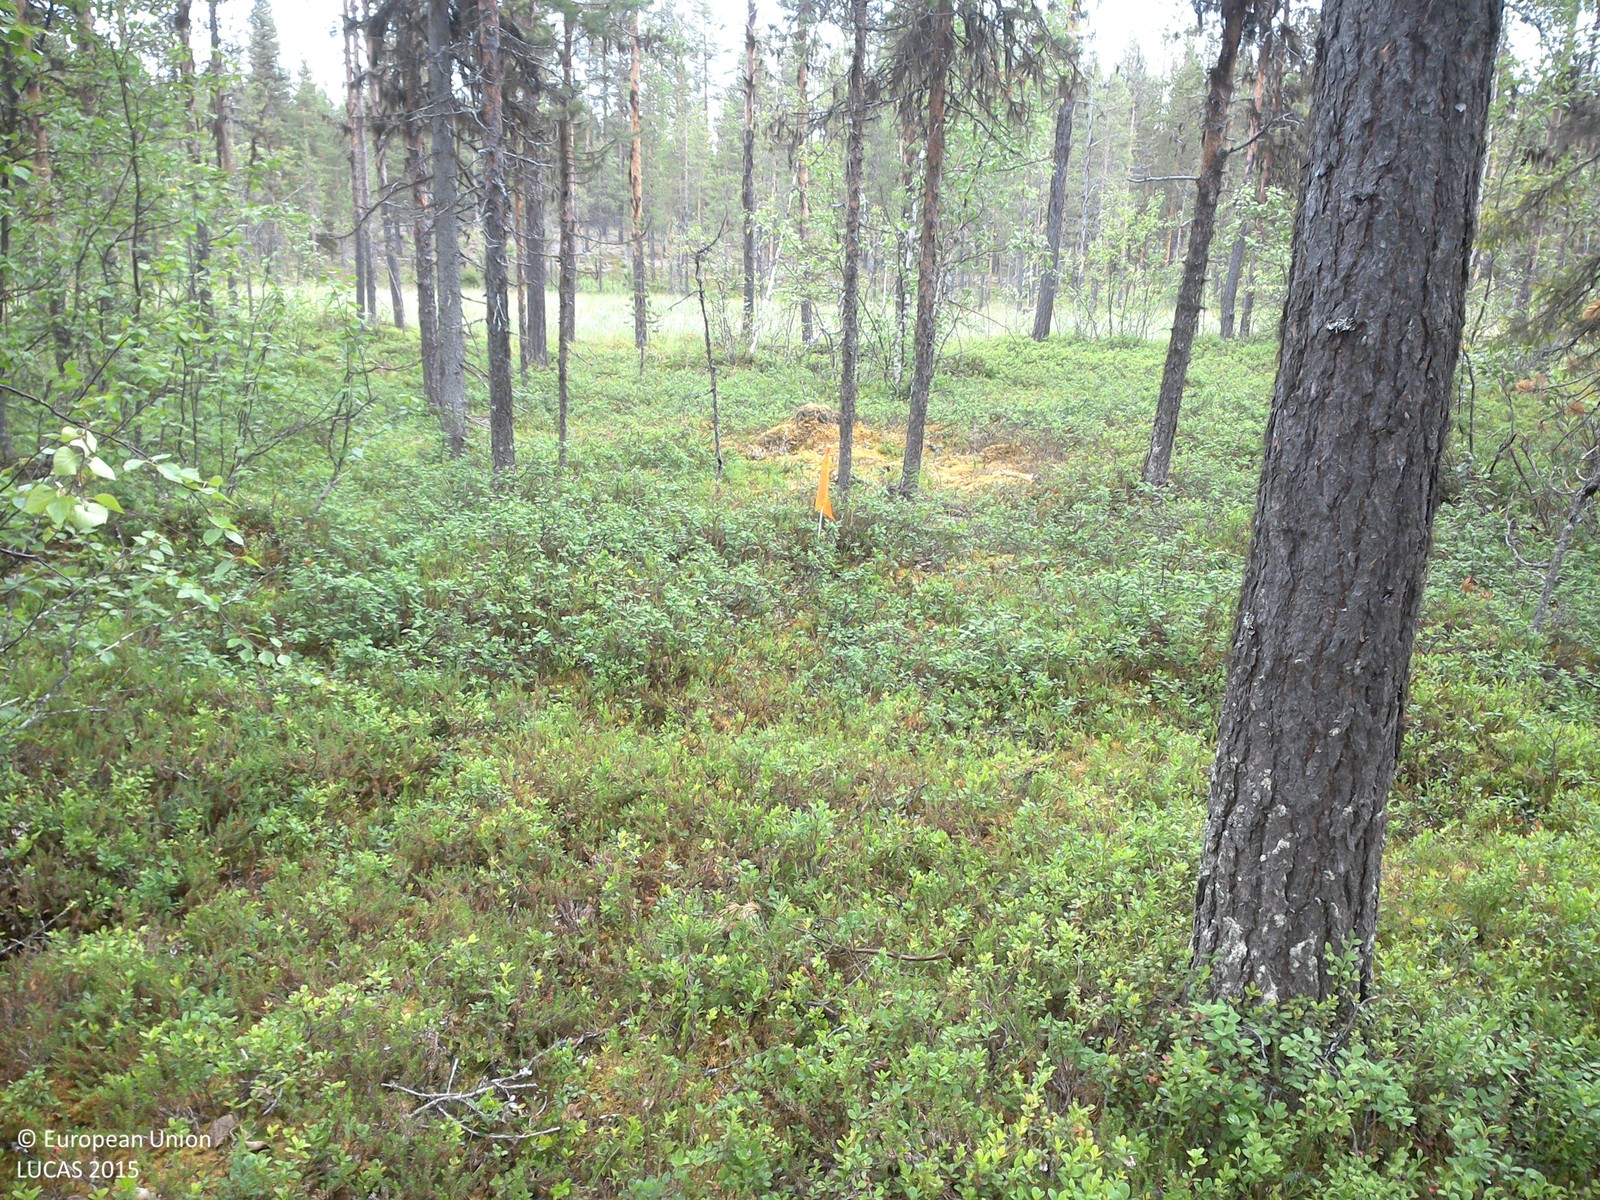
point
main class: Woodland
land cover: Pine dominated mixed woodland
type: boreal forest
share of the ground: 10 - 25 %
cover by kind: shrubs 70 %, coniferous forest trees 15 %, lichens and mosses 10 %, broadleaved forest trees 5 %
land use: Forestry
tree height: > 5 m
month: July
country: SE
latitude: 67.5364
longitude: 22.2676
